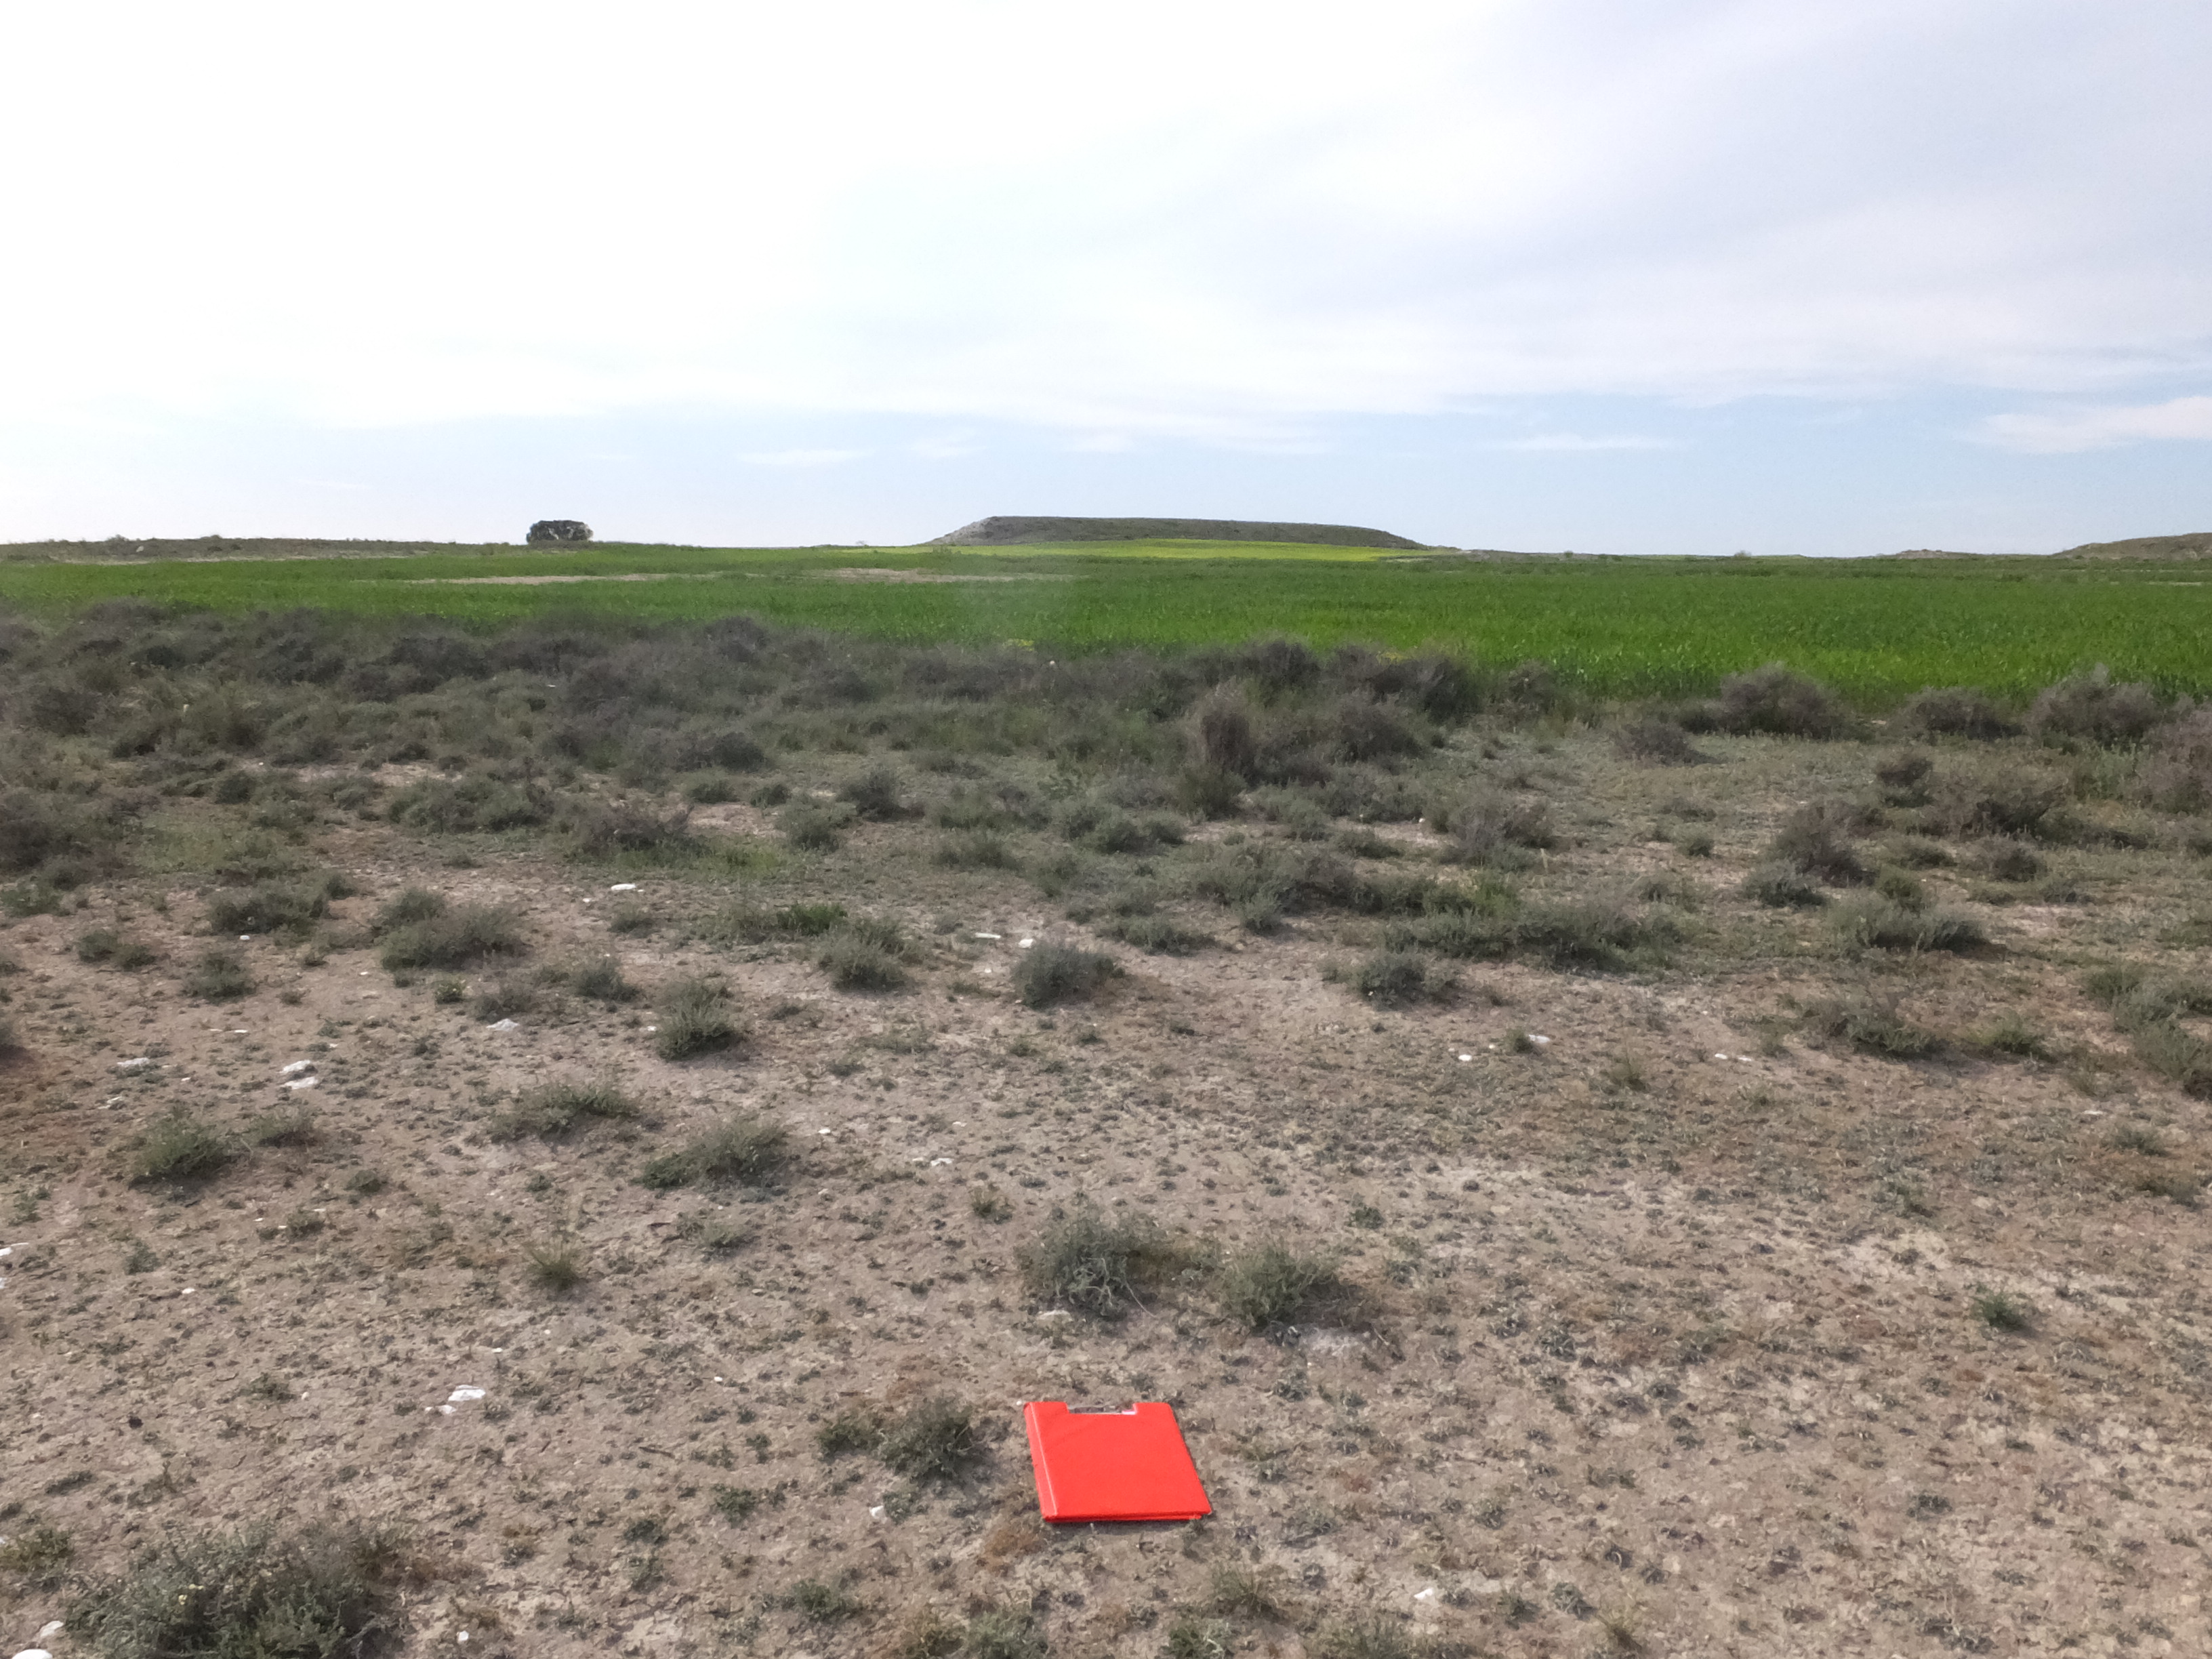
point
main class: Grassland
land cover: Grassland without tree/shrub cover
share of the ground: 50 - 75 %
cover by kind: herbaceous plants 75 %, unconsolidated bare surface 25 %
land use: Semi-natural and natural areas not in use
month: April
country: ES
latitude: 41.5567
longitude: -0.3646
